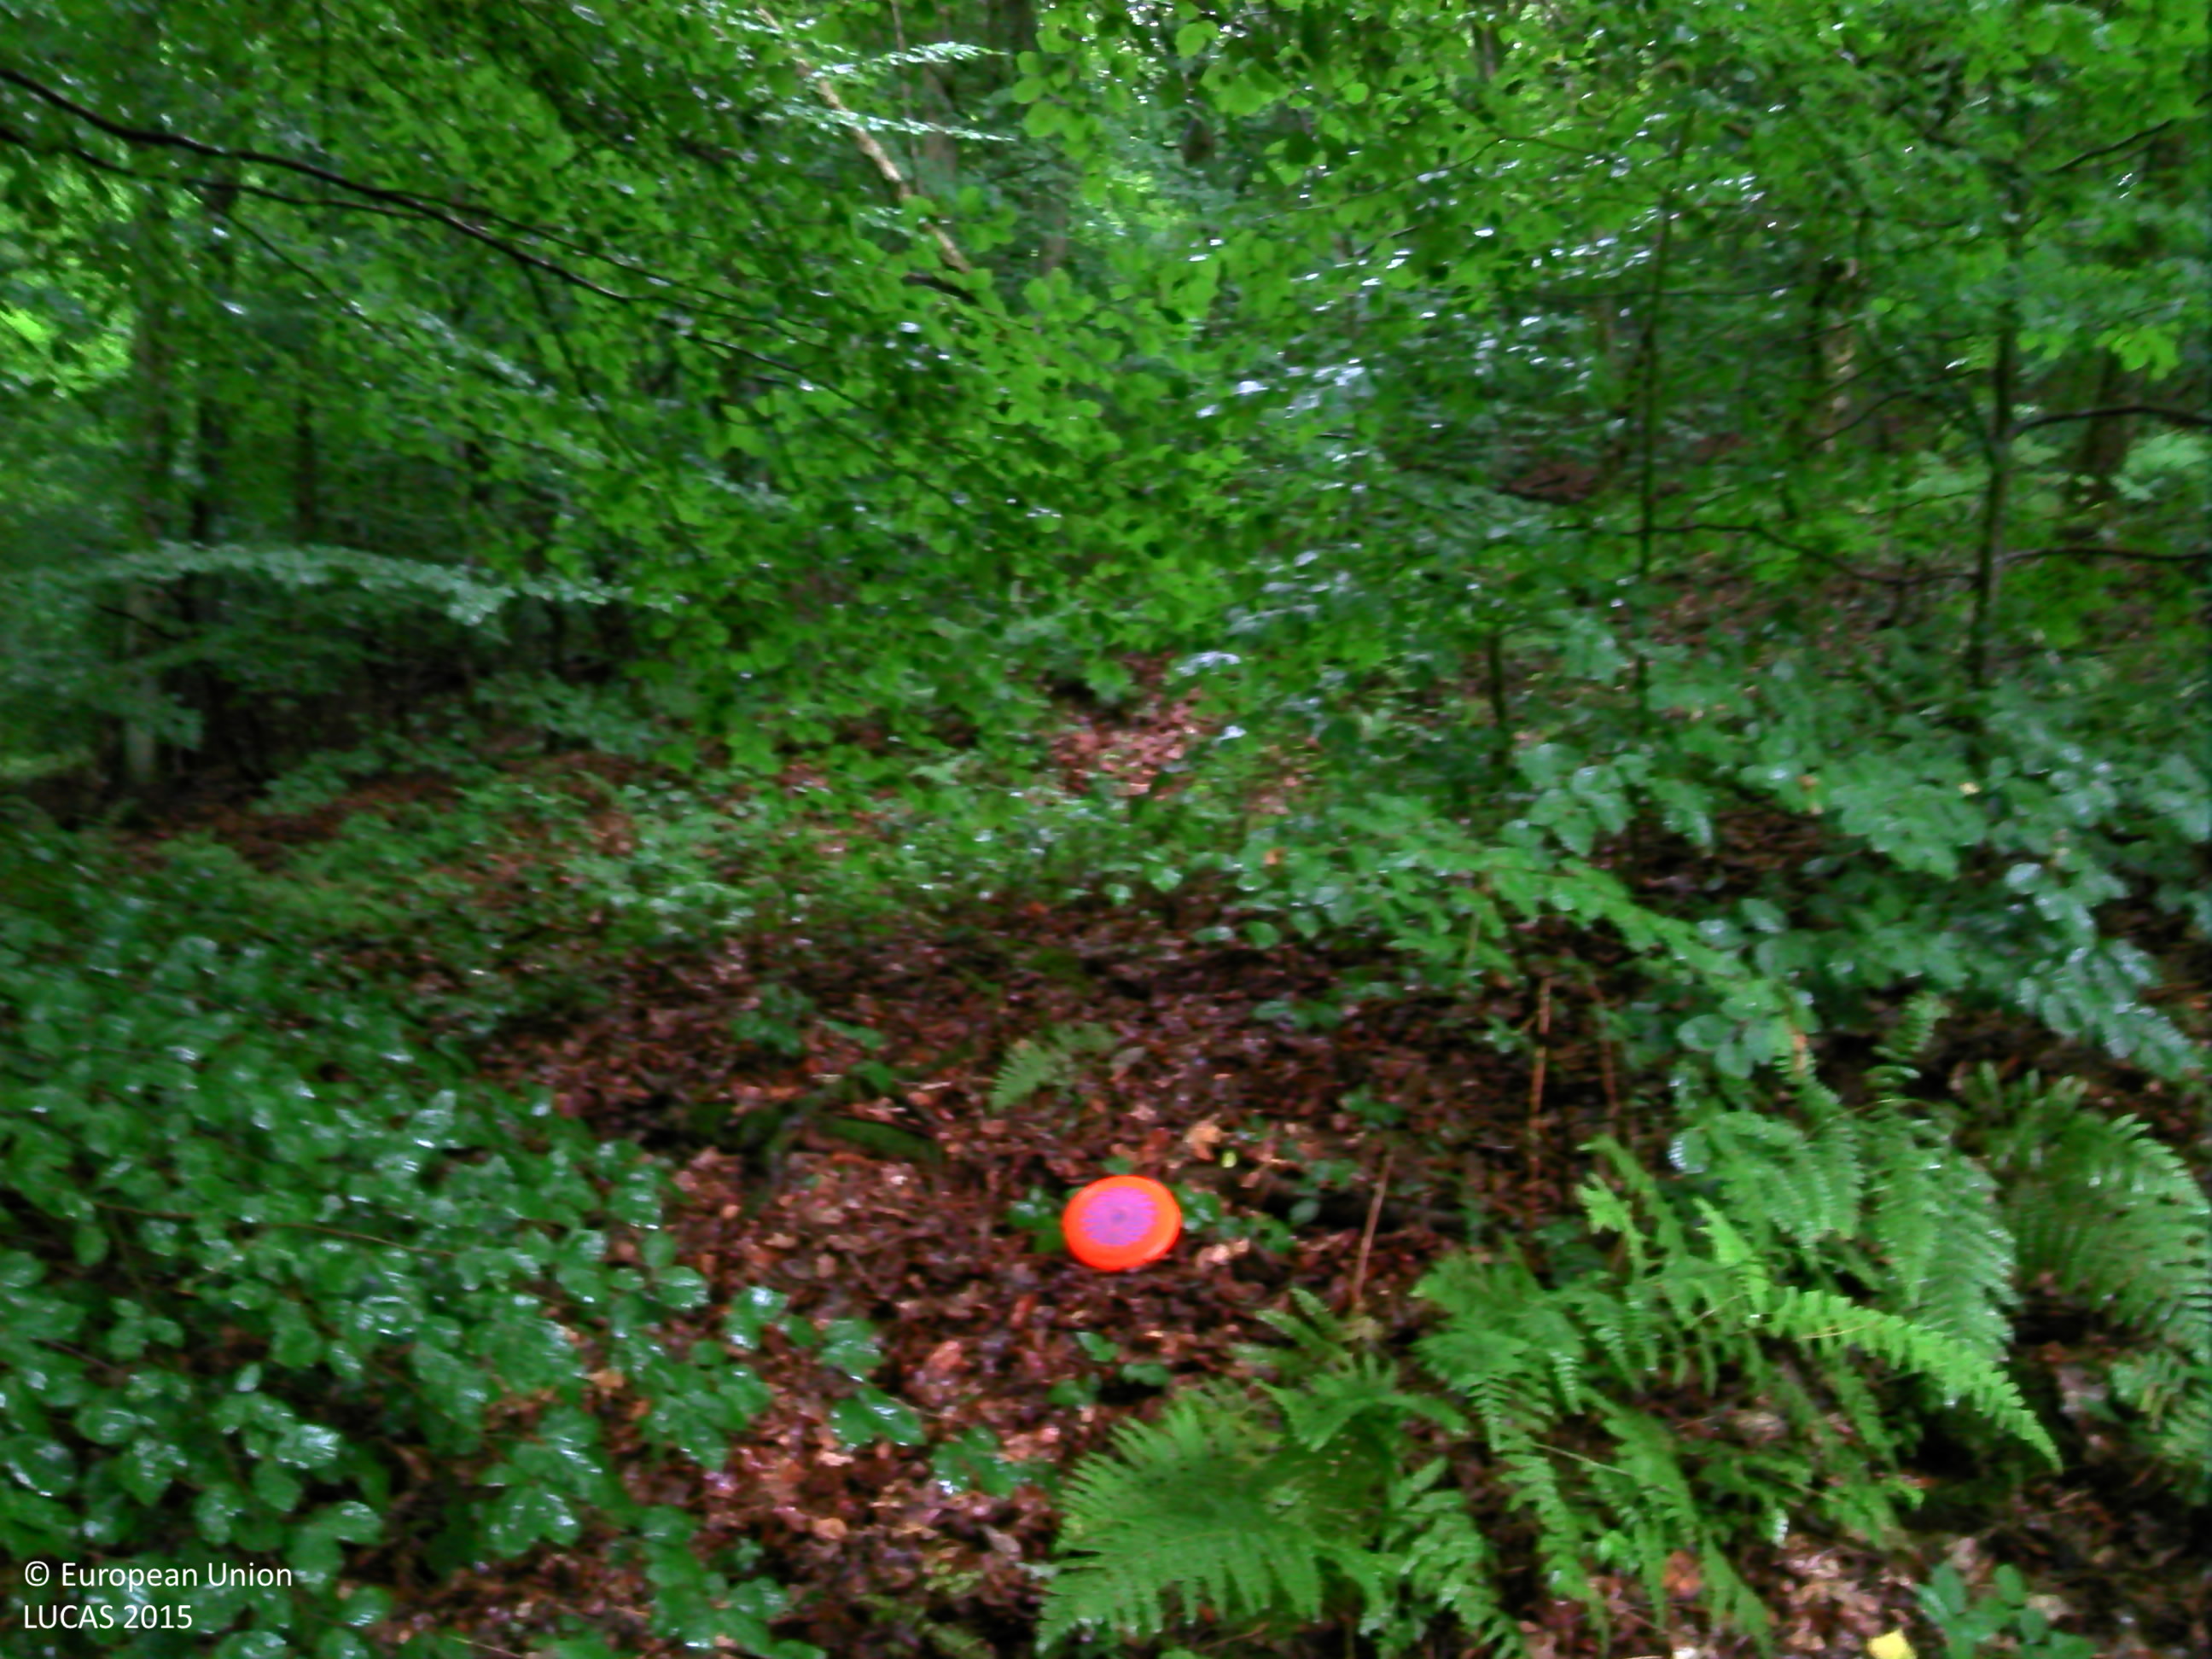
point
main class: Woodland
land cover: Broadleaved woodland
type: acidophilous oak and oak-birch forest
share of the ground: > 75 %
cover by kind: broadleaved forest trees 95 %, herbaceous plants 5 %
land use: Forestry
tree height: > 5 m
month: July
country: BE
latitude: 50.5197
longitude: 5.3011
